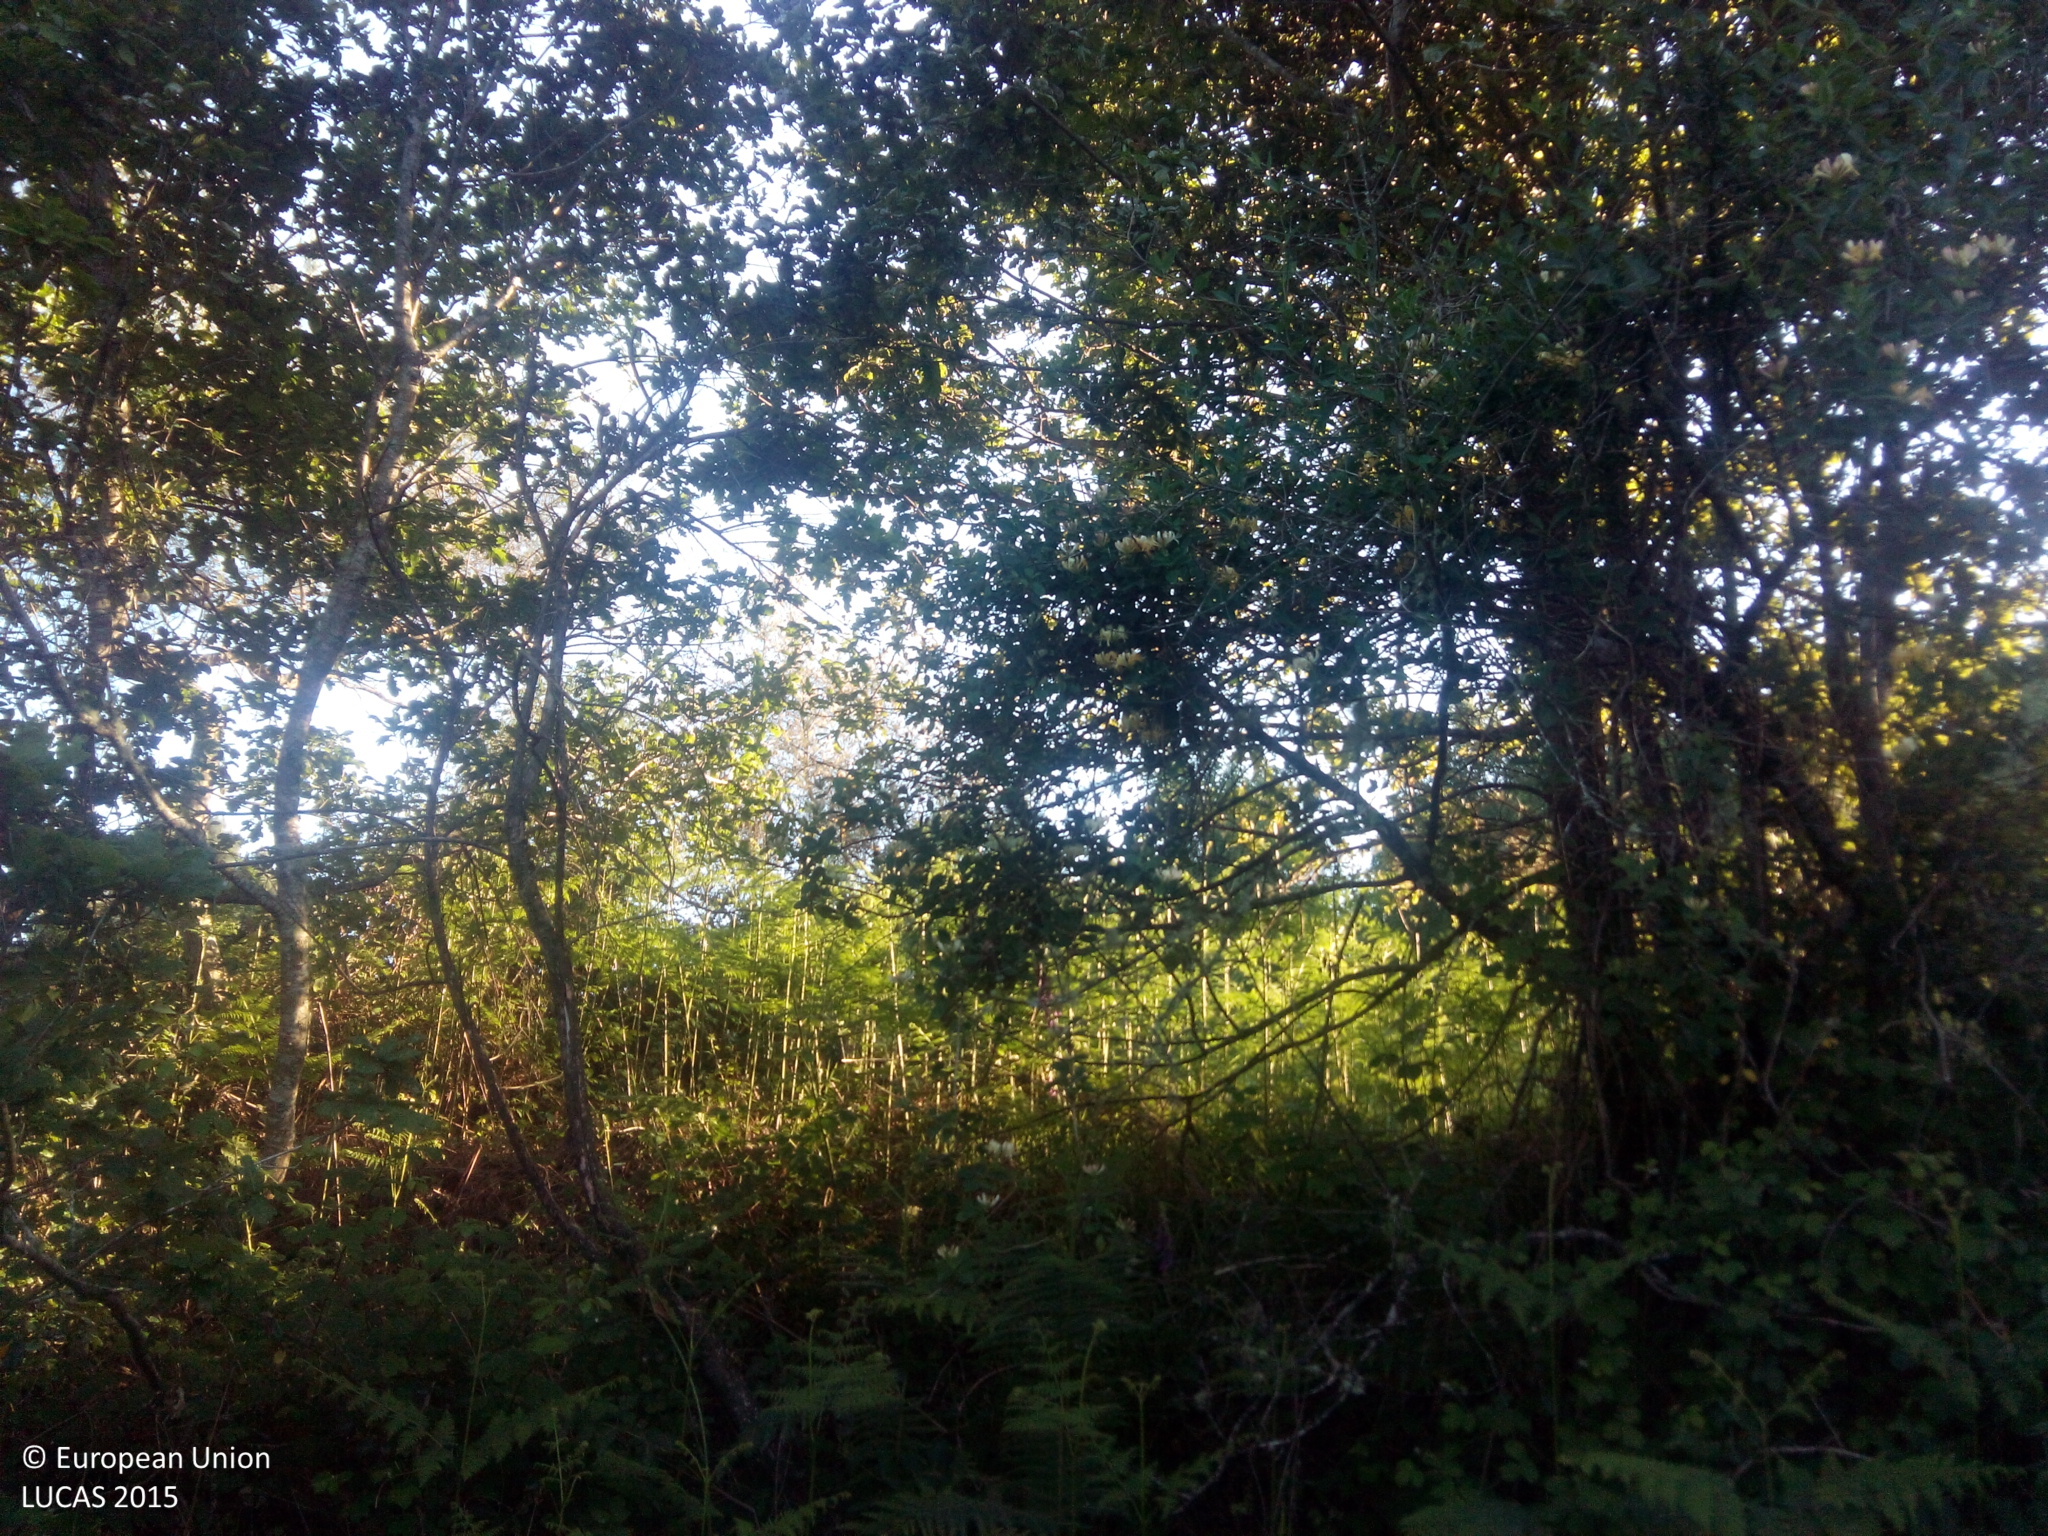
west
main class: Grassland
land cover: Grassland with sparse tree/shrub cover
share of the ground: > 75 %
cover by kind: herbaceous plants 95 %, broadleaved forest trees 5 %
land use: Agriculture (excluding fallow land and kitchen gardens)
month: June
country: ES
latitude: 42.2436
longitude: -8.3036
